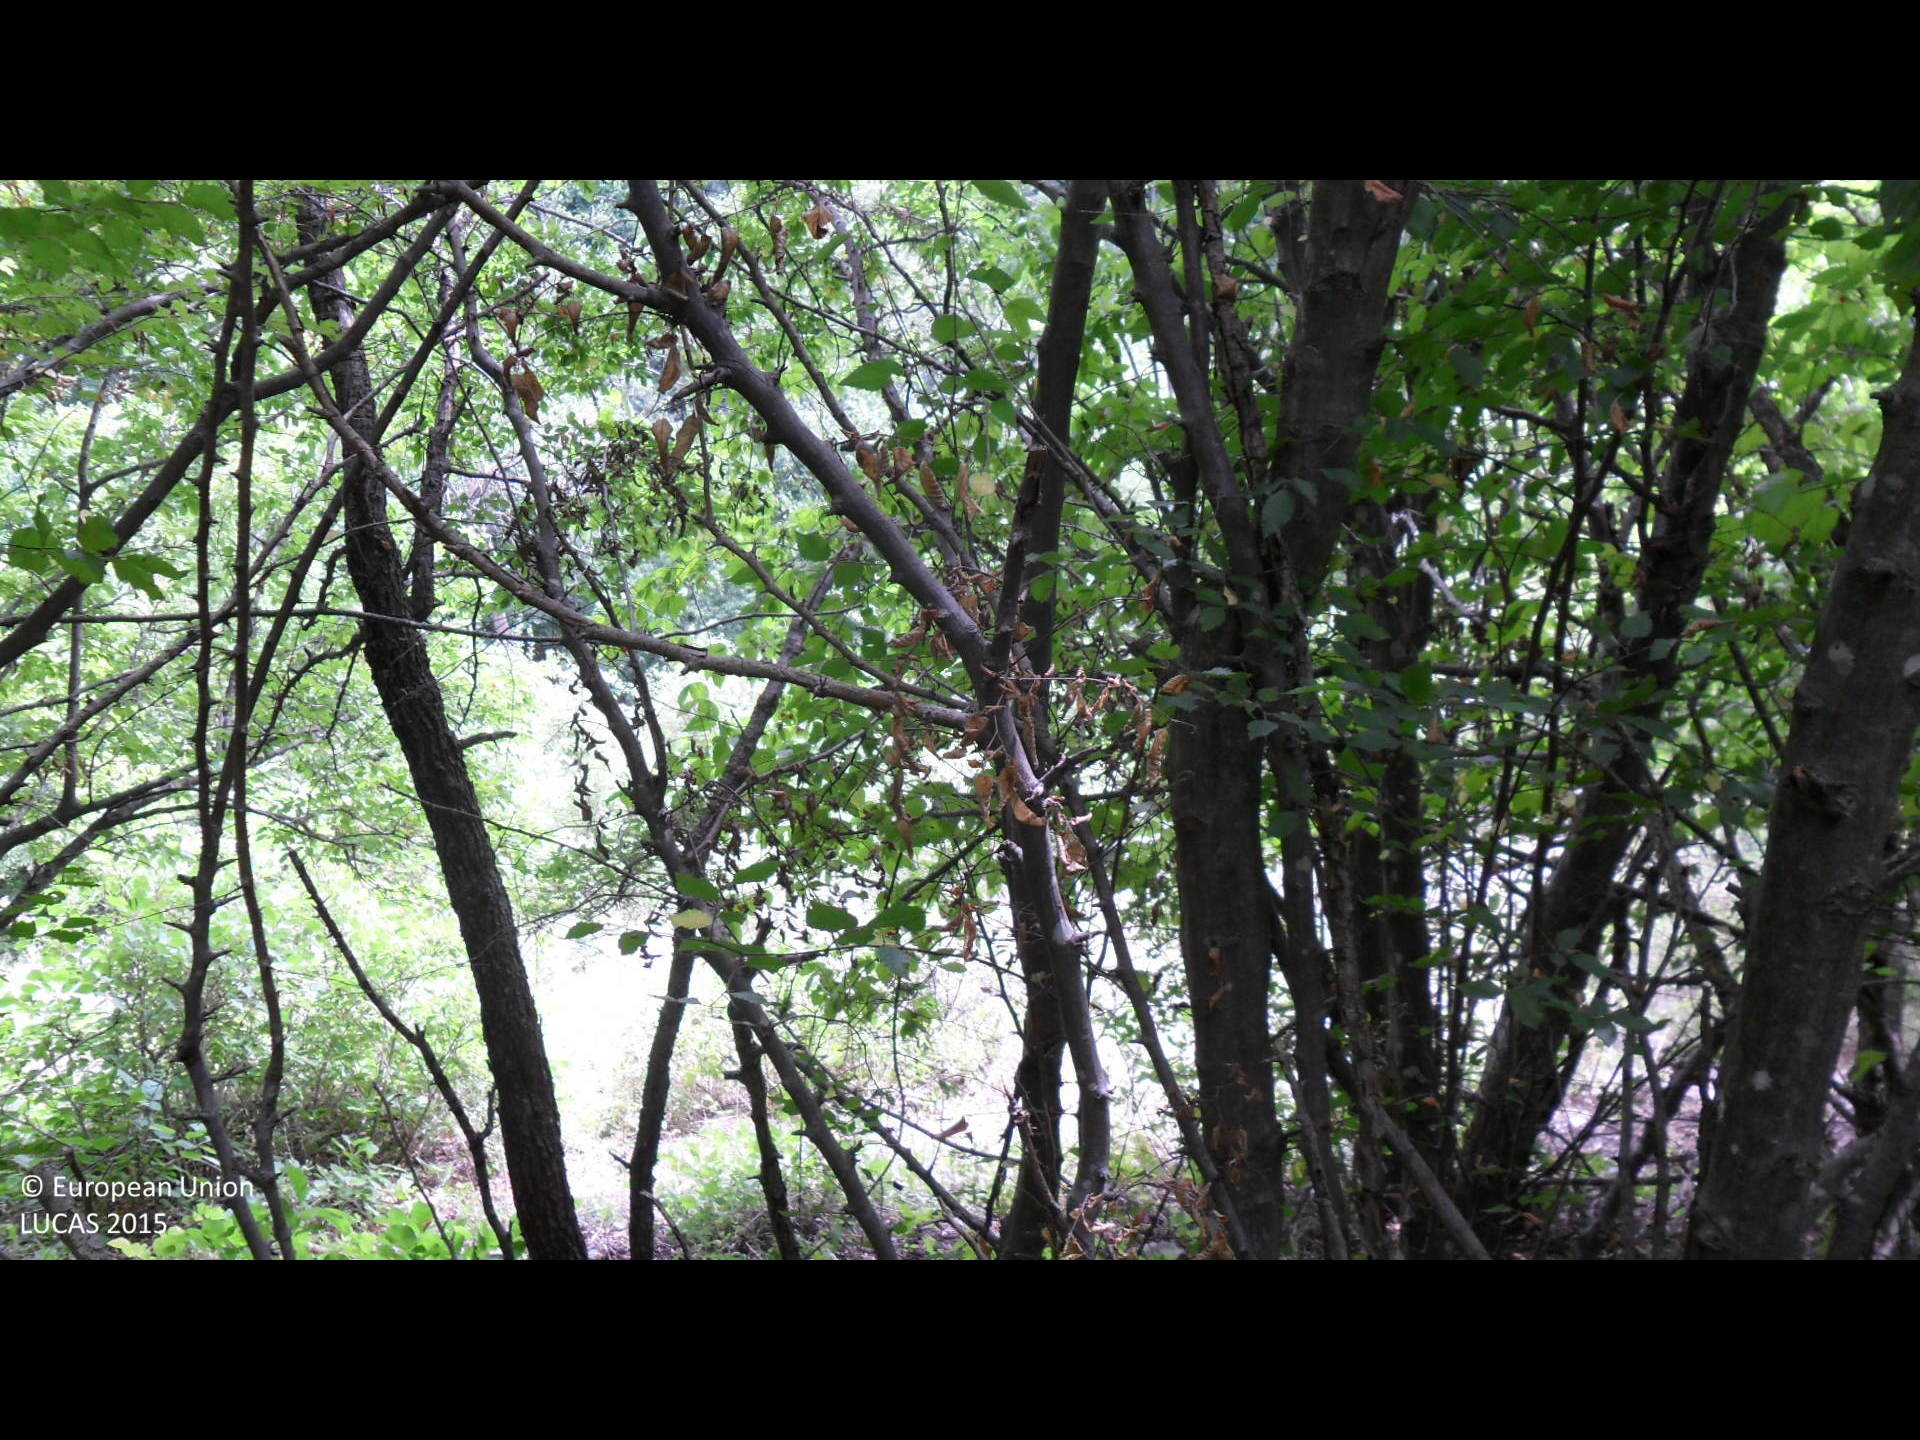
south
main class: Woodland
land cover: Broadleaved woodland
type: mesophytic deciduous forest
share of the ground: 50 - 75 %
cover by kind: broadleaved forest trees 100 %
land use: Forestry
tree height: > 5 m
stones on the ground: 10 - 25 %
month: August
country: BG
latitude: 43.5137
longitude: 26.1657
